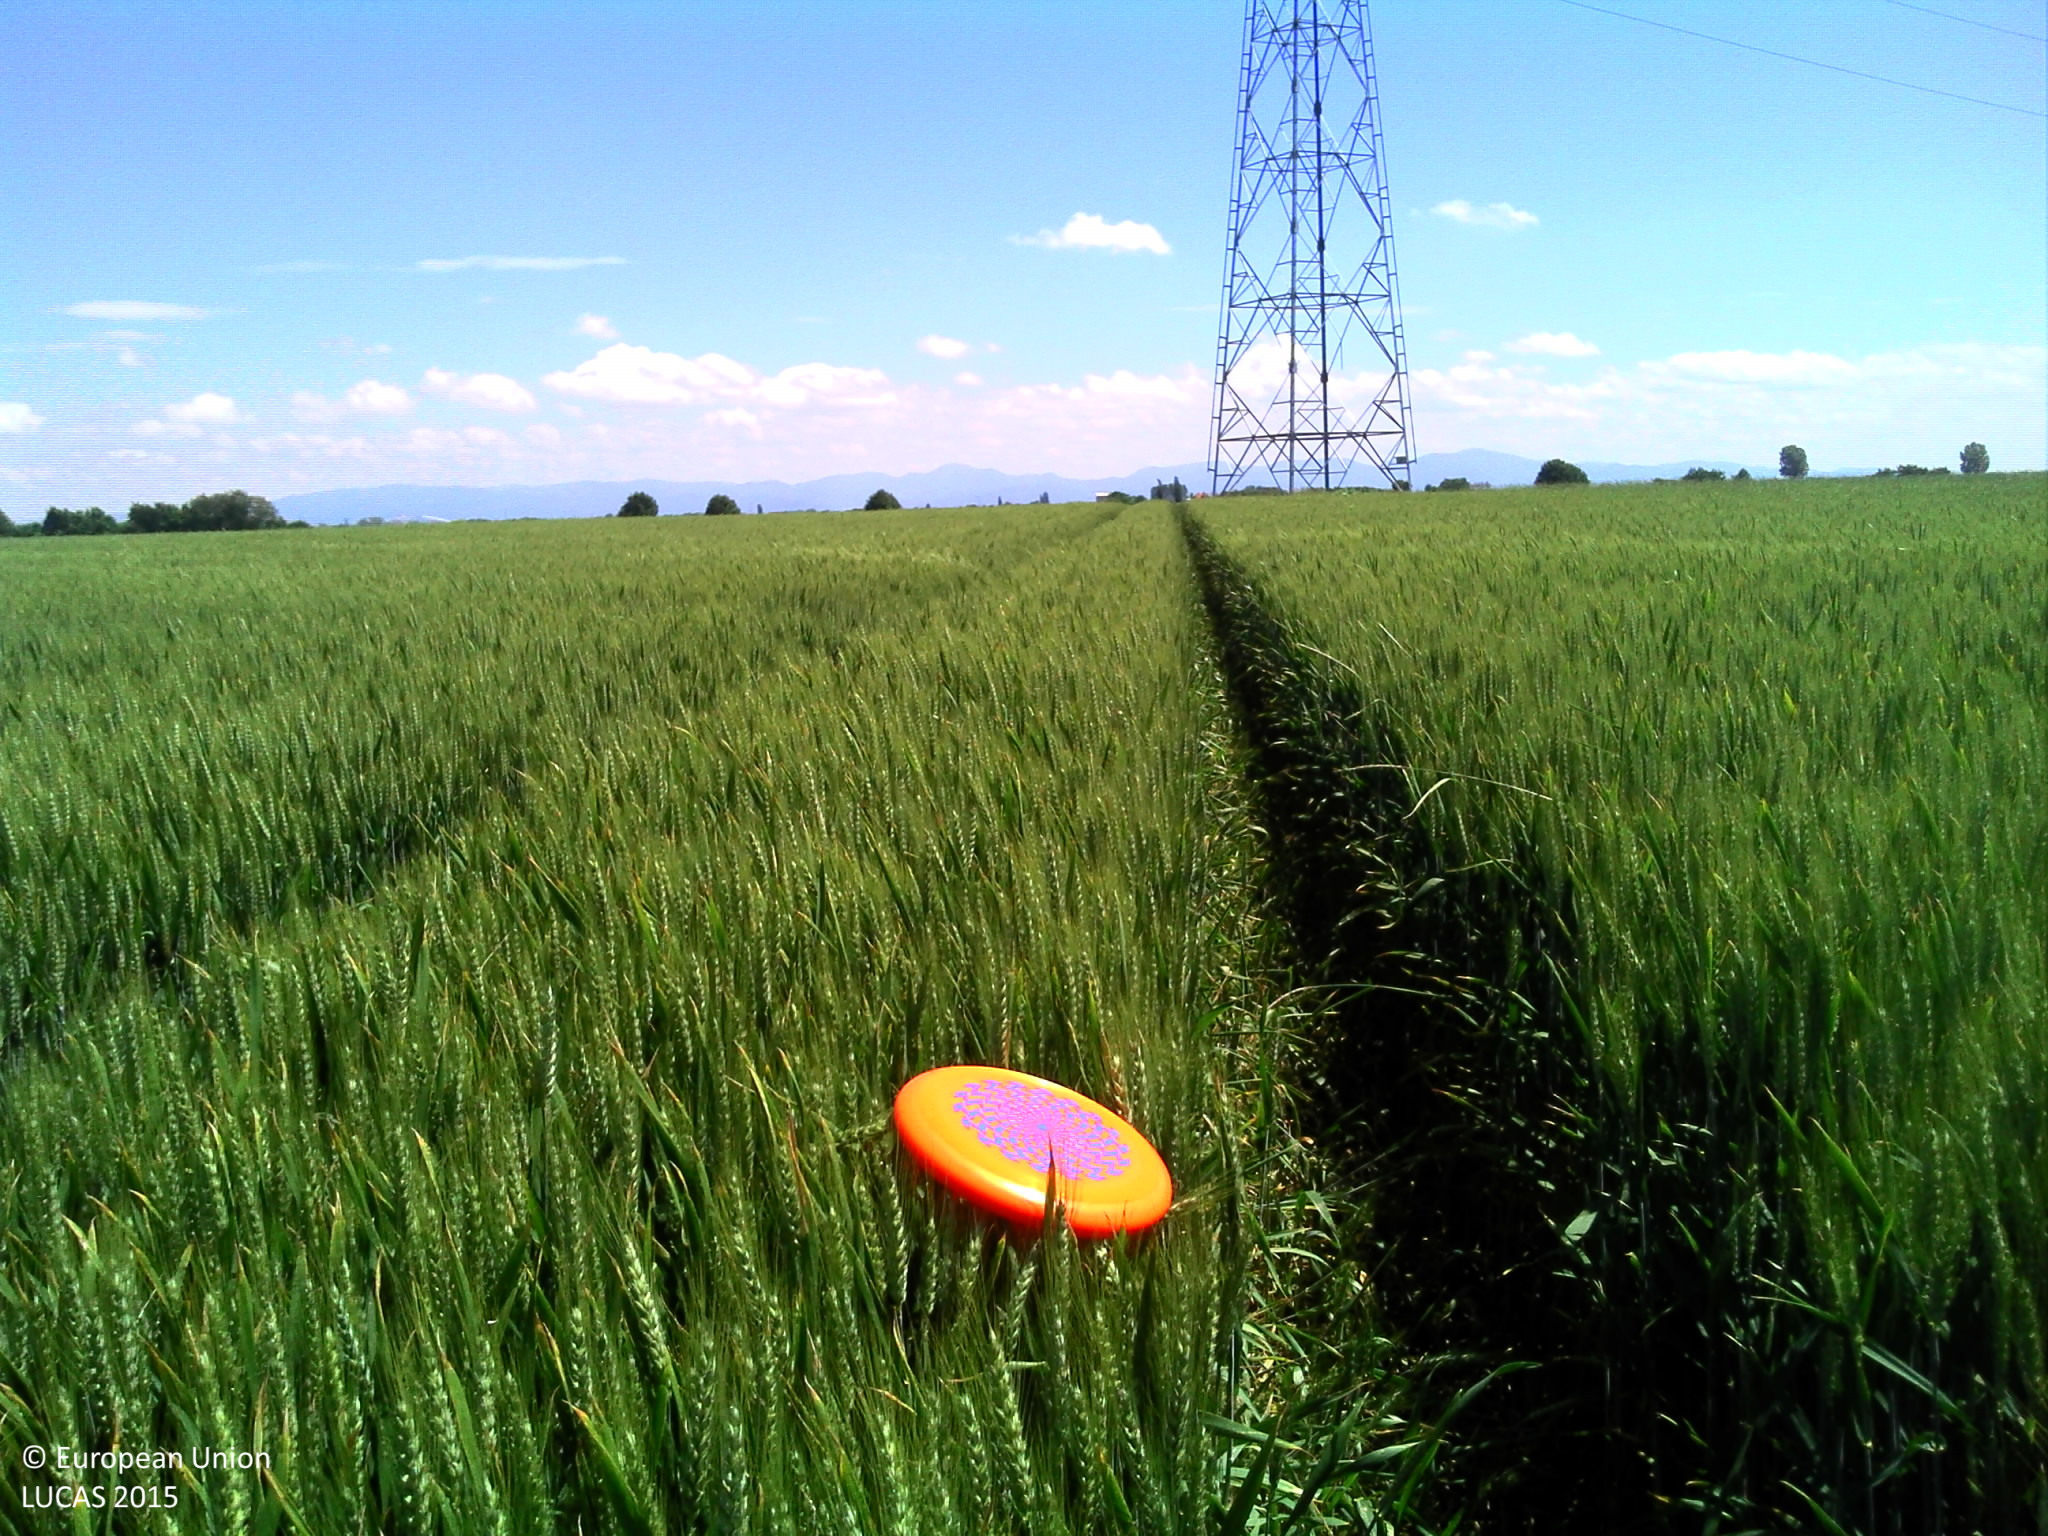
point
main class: Cropland
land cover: Common wheat
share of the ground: > 75 %
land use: Agriculture (excluding fallow land and kitchen gardens)
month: June
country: FR
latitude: 47.9759
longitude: 7.3622
